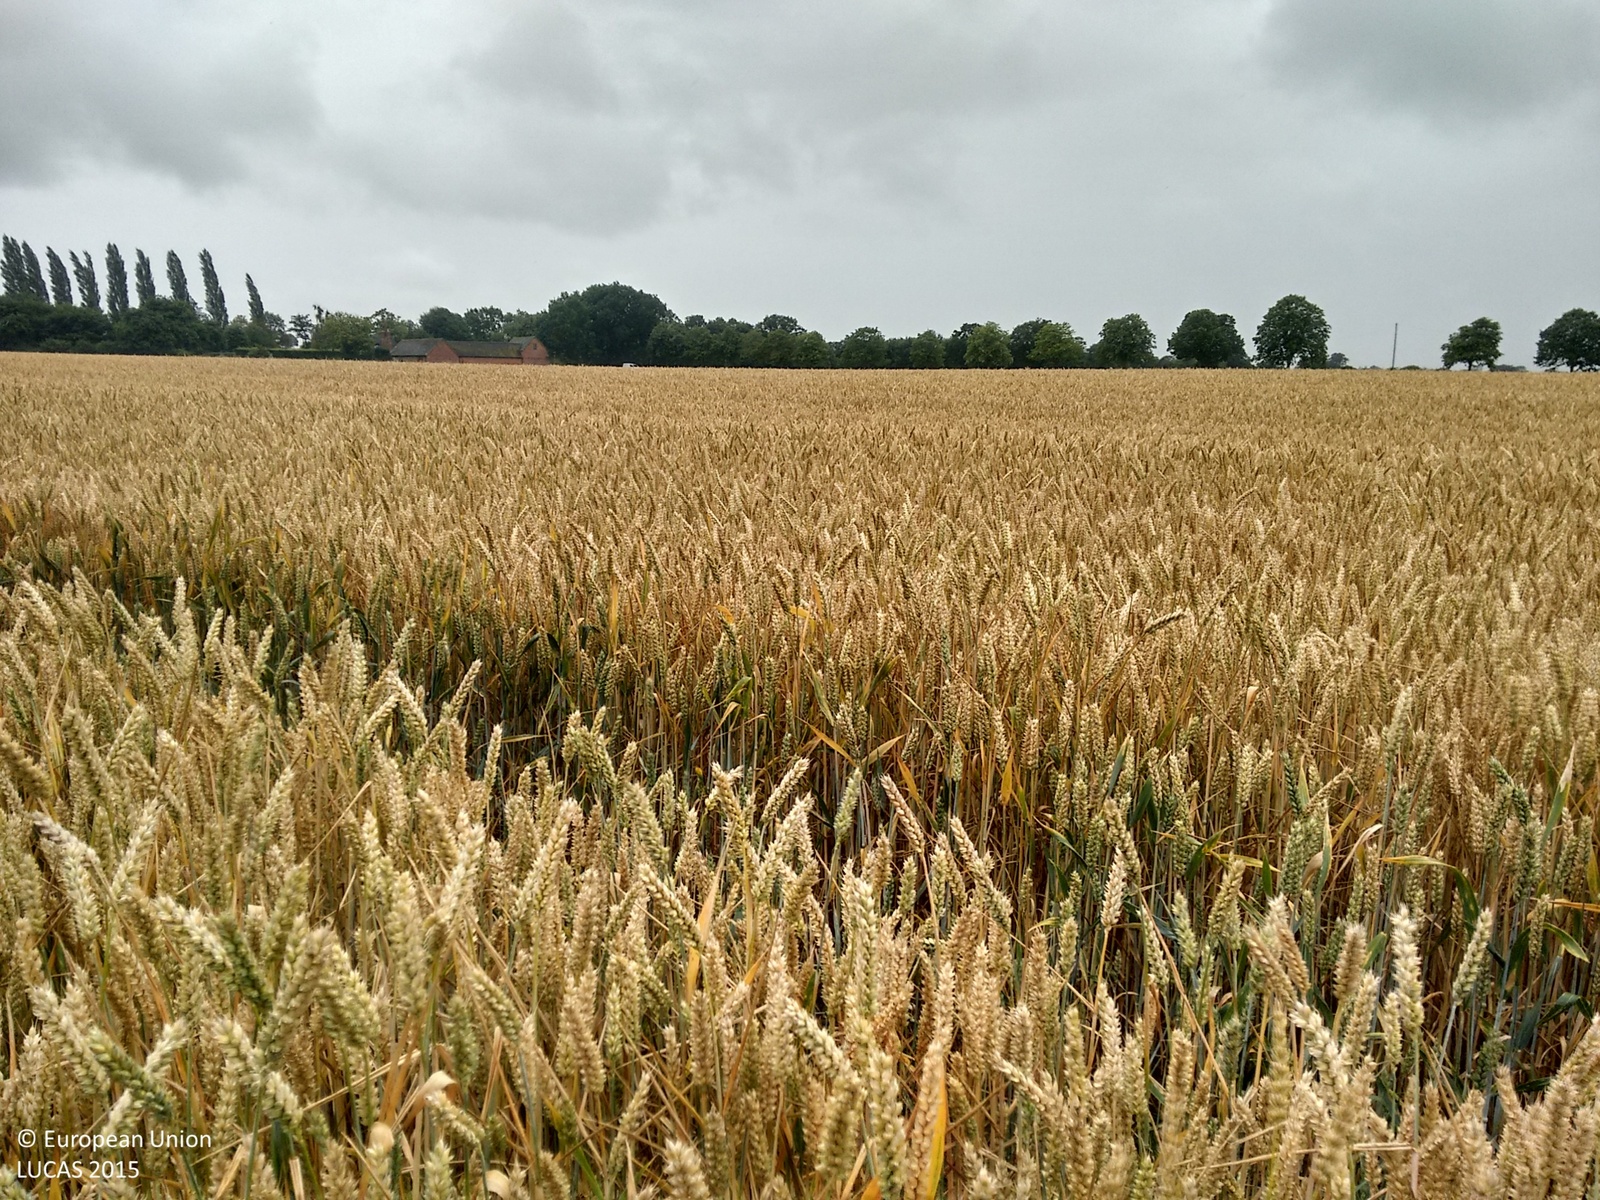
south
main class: Cropland
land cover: Common wheat
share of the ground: > 75 %
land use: Agriculture (excluding fallow land and kitchen gardens)
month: July
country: GB
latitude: 52.6491
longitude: -2.2565
